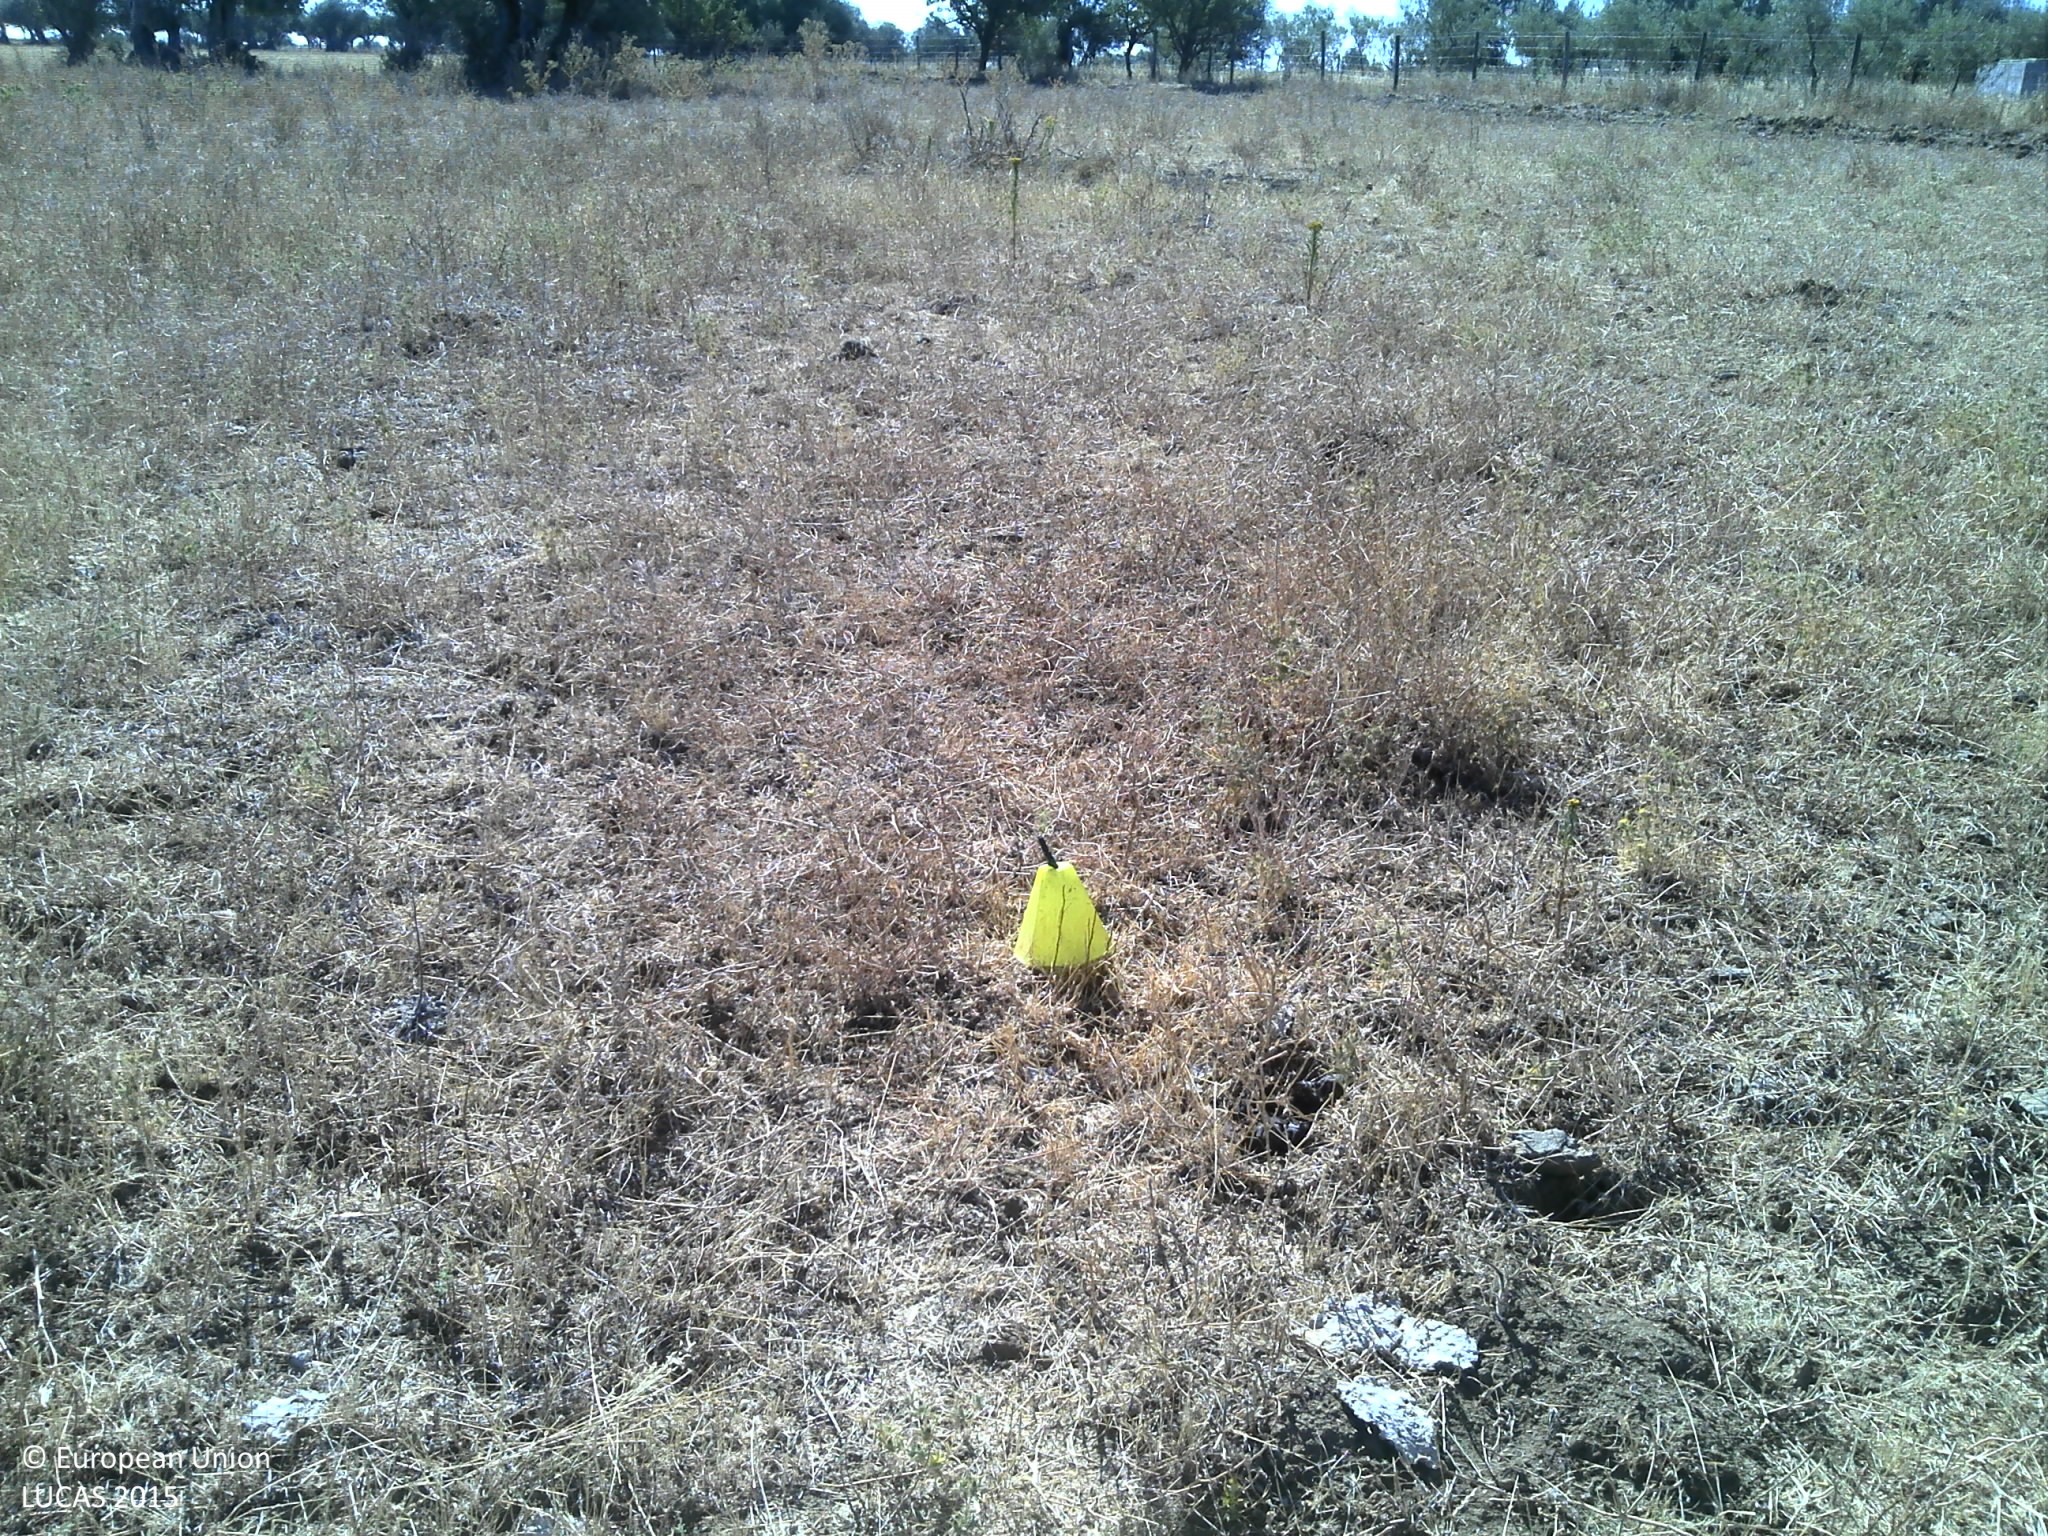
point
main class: Grassland
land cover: Grassland without tree/shrub cover
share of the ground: 25 - 50 %
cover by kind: unconsolidated bare surface 70 %, herbaceous plants 30 %
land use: Agriculture (excluding fallow land and kitchen gardens)
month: July
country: PT
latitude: 38.9581
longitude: -7.4968
